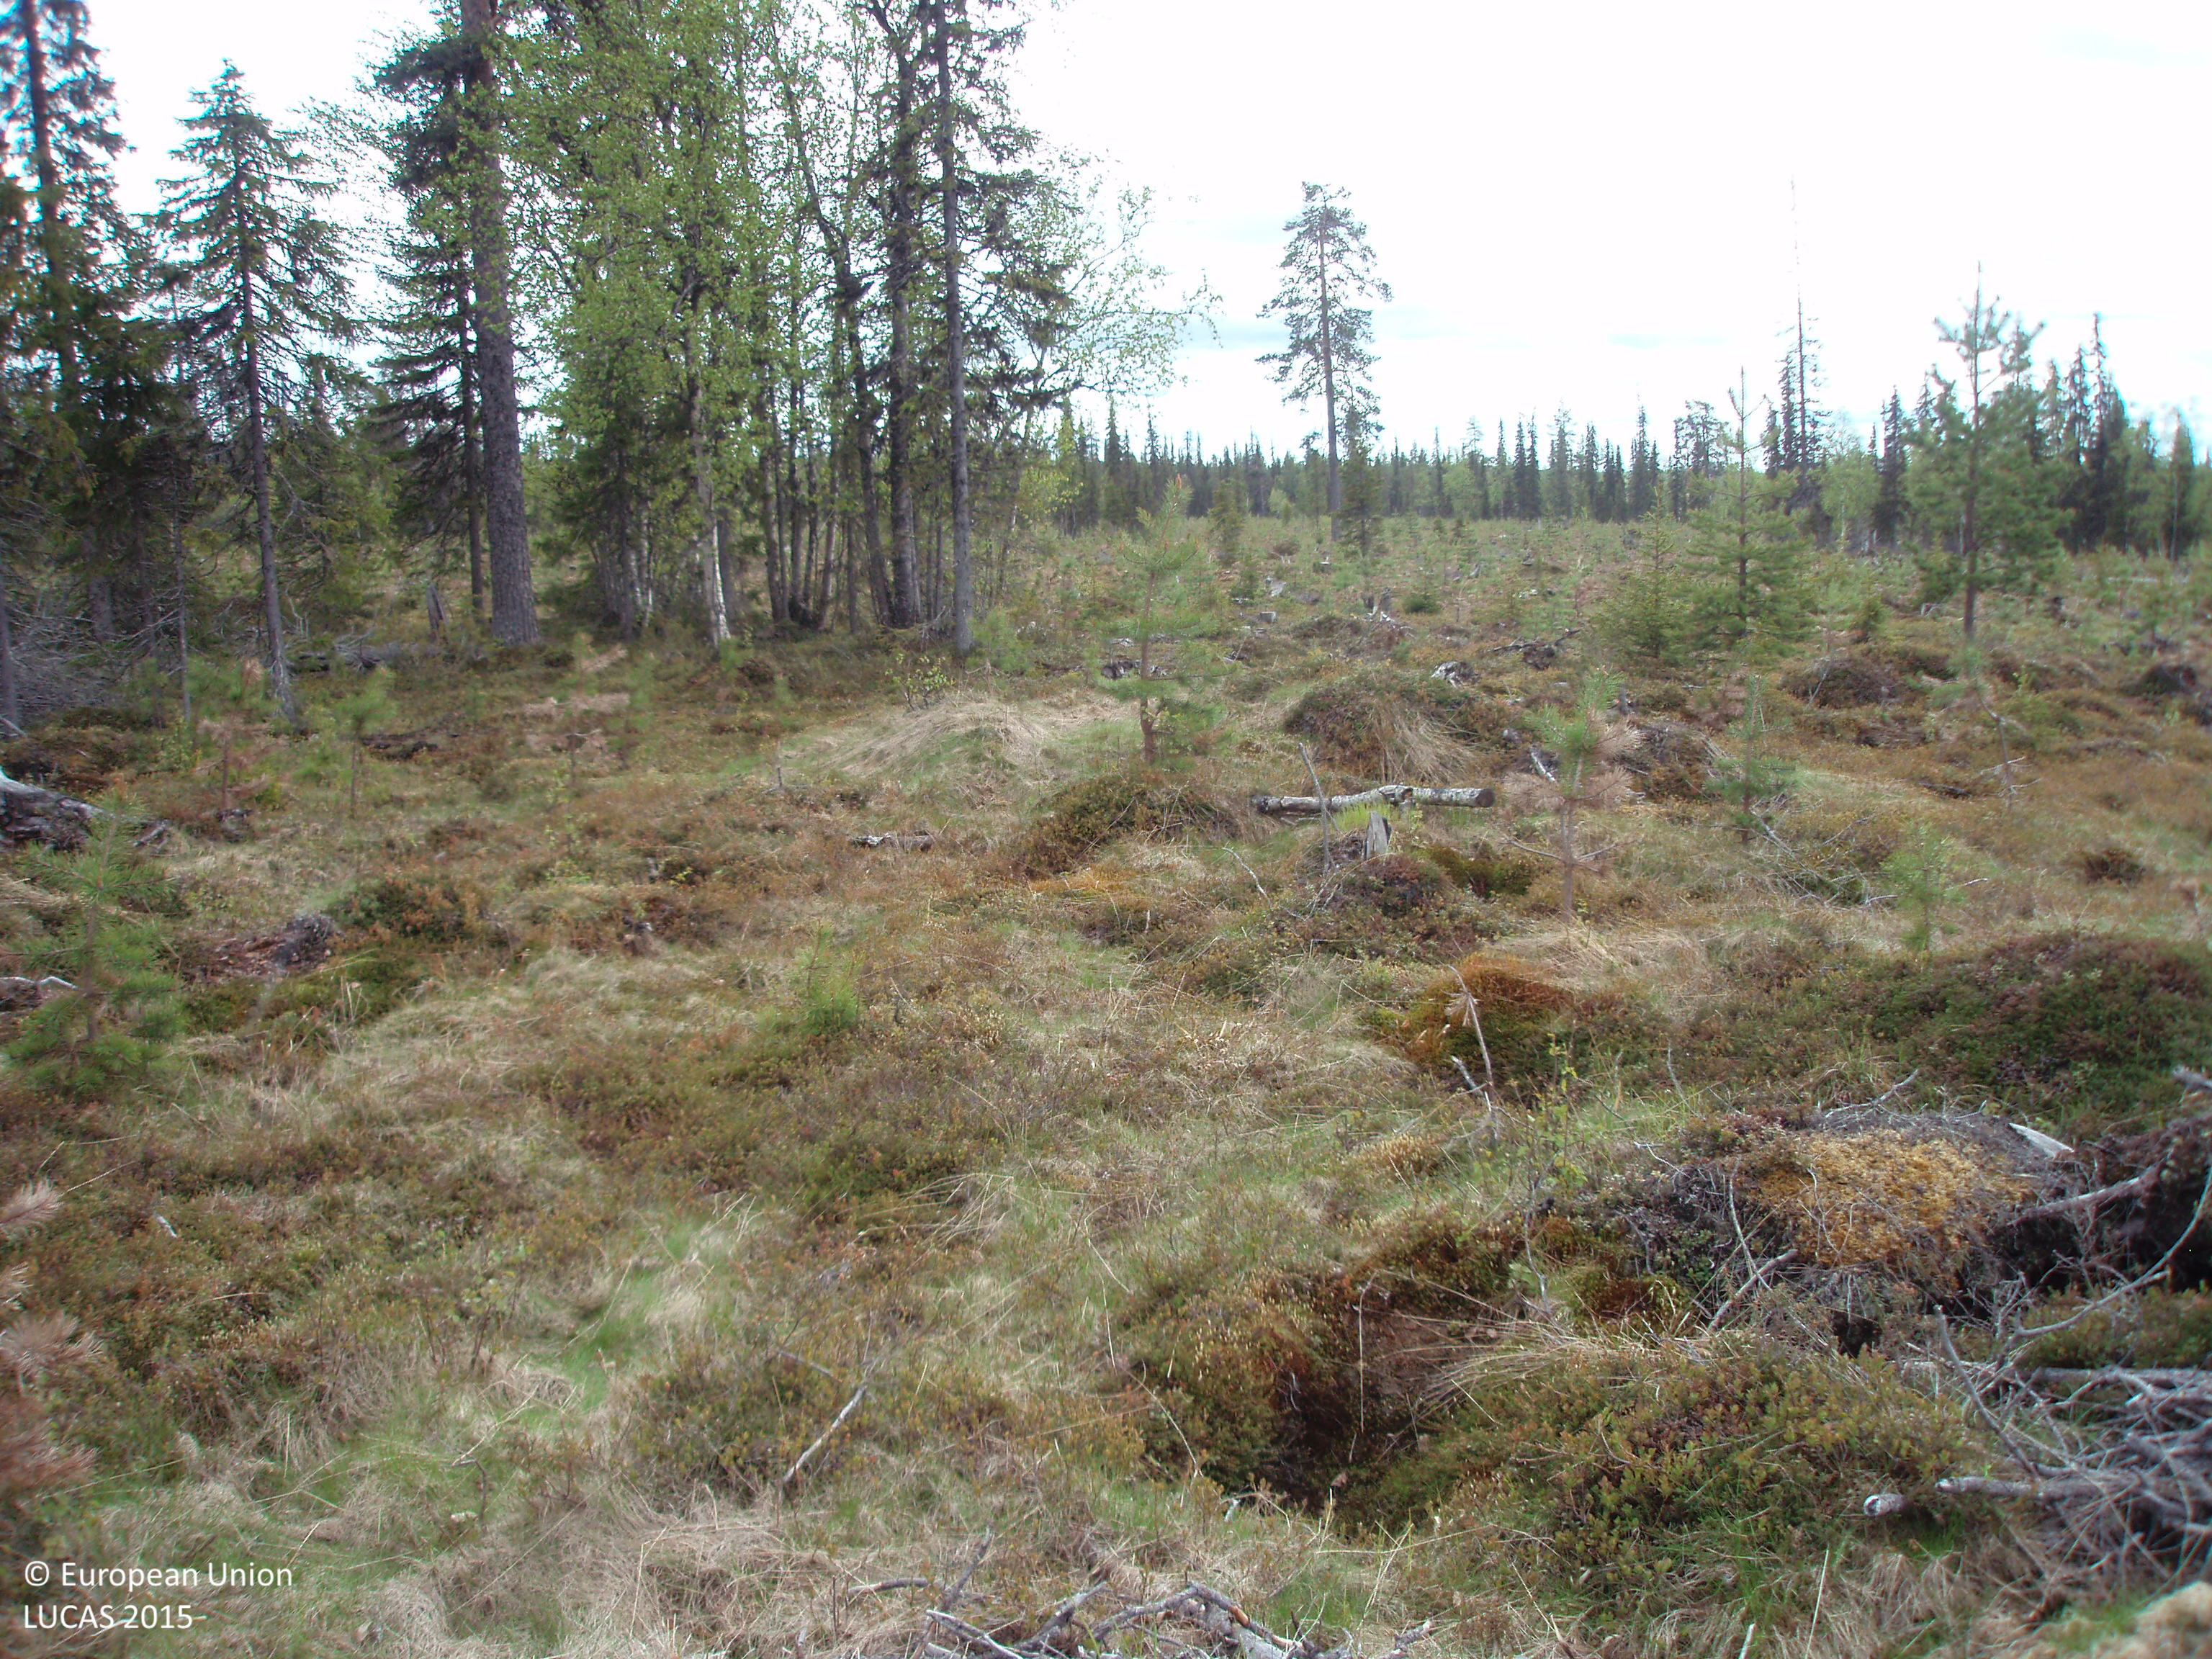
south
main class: Shrubland
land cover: Shrubland with sparse tree cover
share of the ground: 50 - 75 %
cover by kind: shrubs 55 %, herbaceous plants 40 %, coniferous forest trees 5 %
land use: Forestry
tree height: < 5 m
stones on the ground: < 10 %
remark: Clear cut
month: June
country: FI
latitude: 67.9450
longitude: 26.9470
